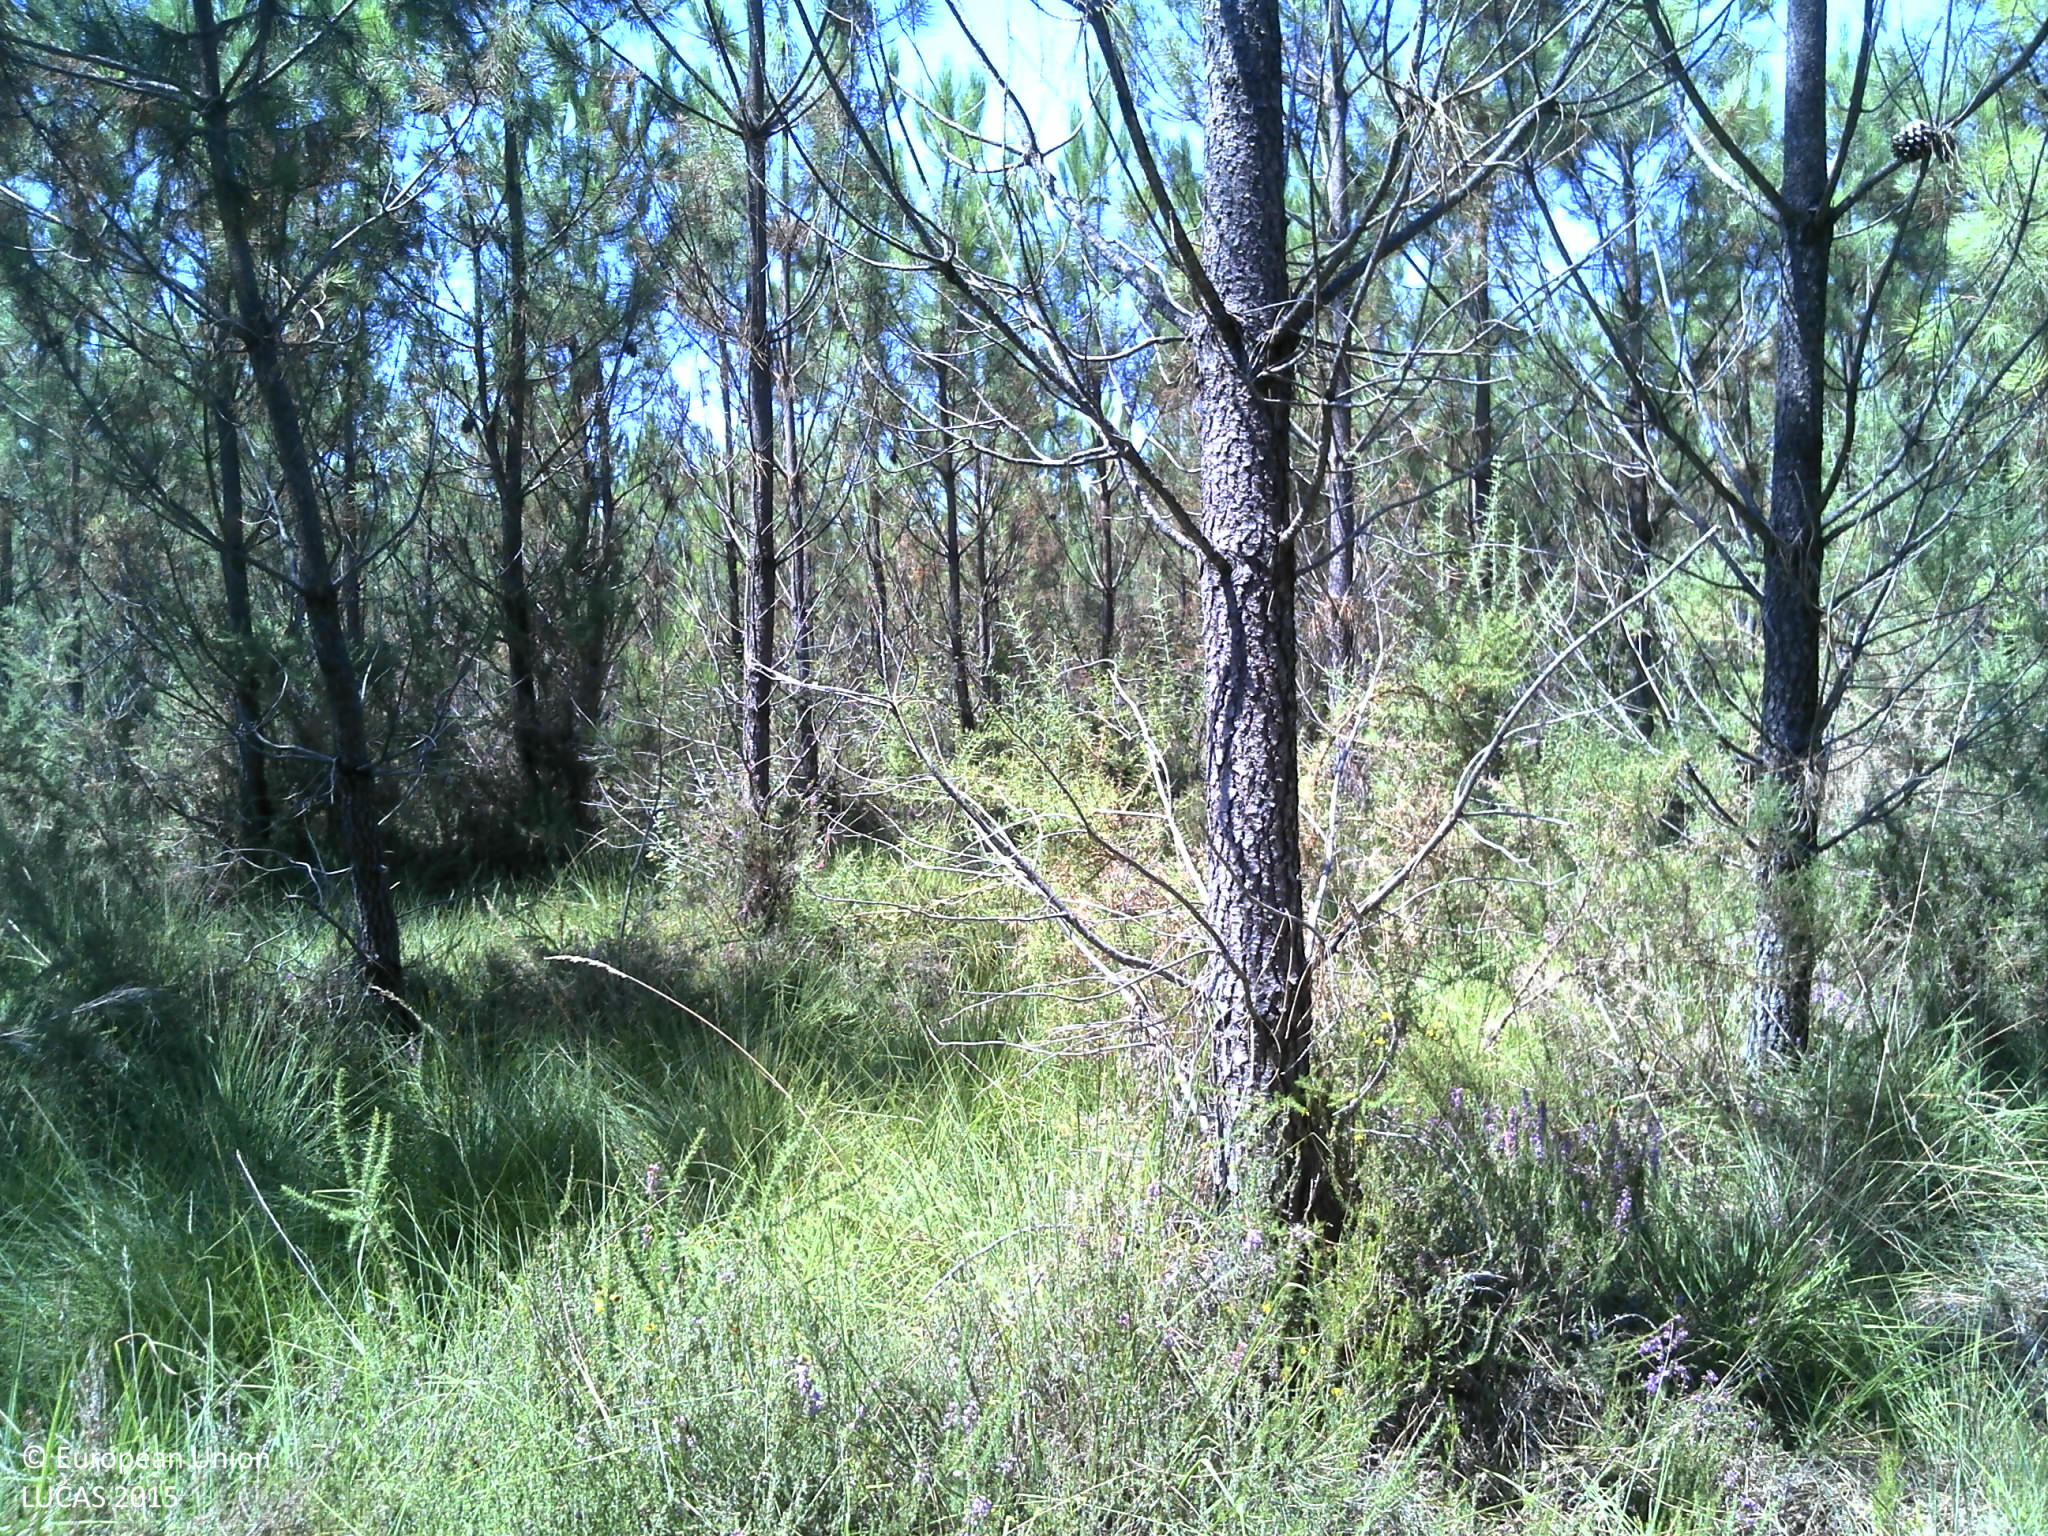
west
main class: Woodland
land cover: Pine dominated coniferous woodland
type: exotic forest
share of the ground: > 75 %
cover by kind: coniferous forest trees 60 %, shrubs 30 %, herbaceous plants 5 %, lichens and mosses 5 %
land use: Forestry
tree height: > 5 m
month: August
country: FR
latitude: 44.4618
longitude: -0.5867
